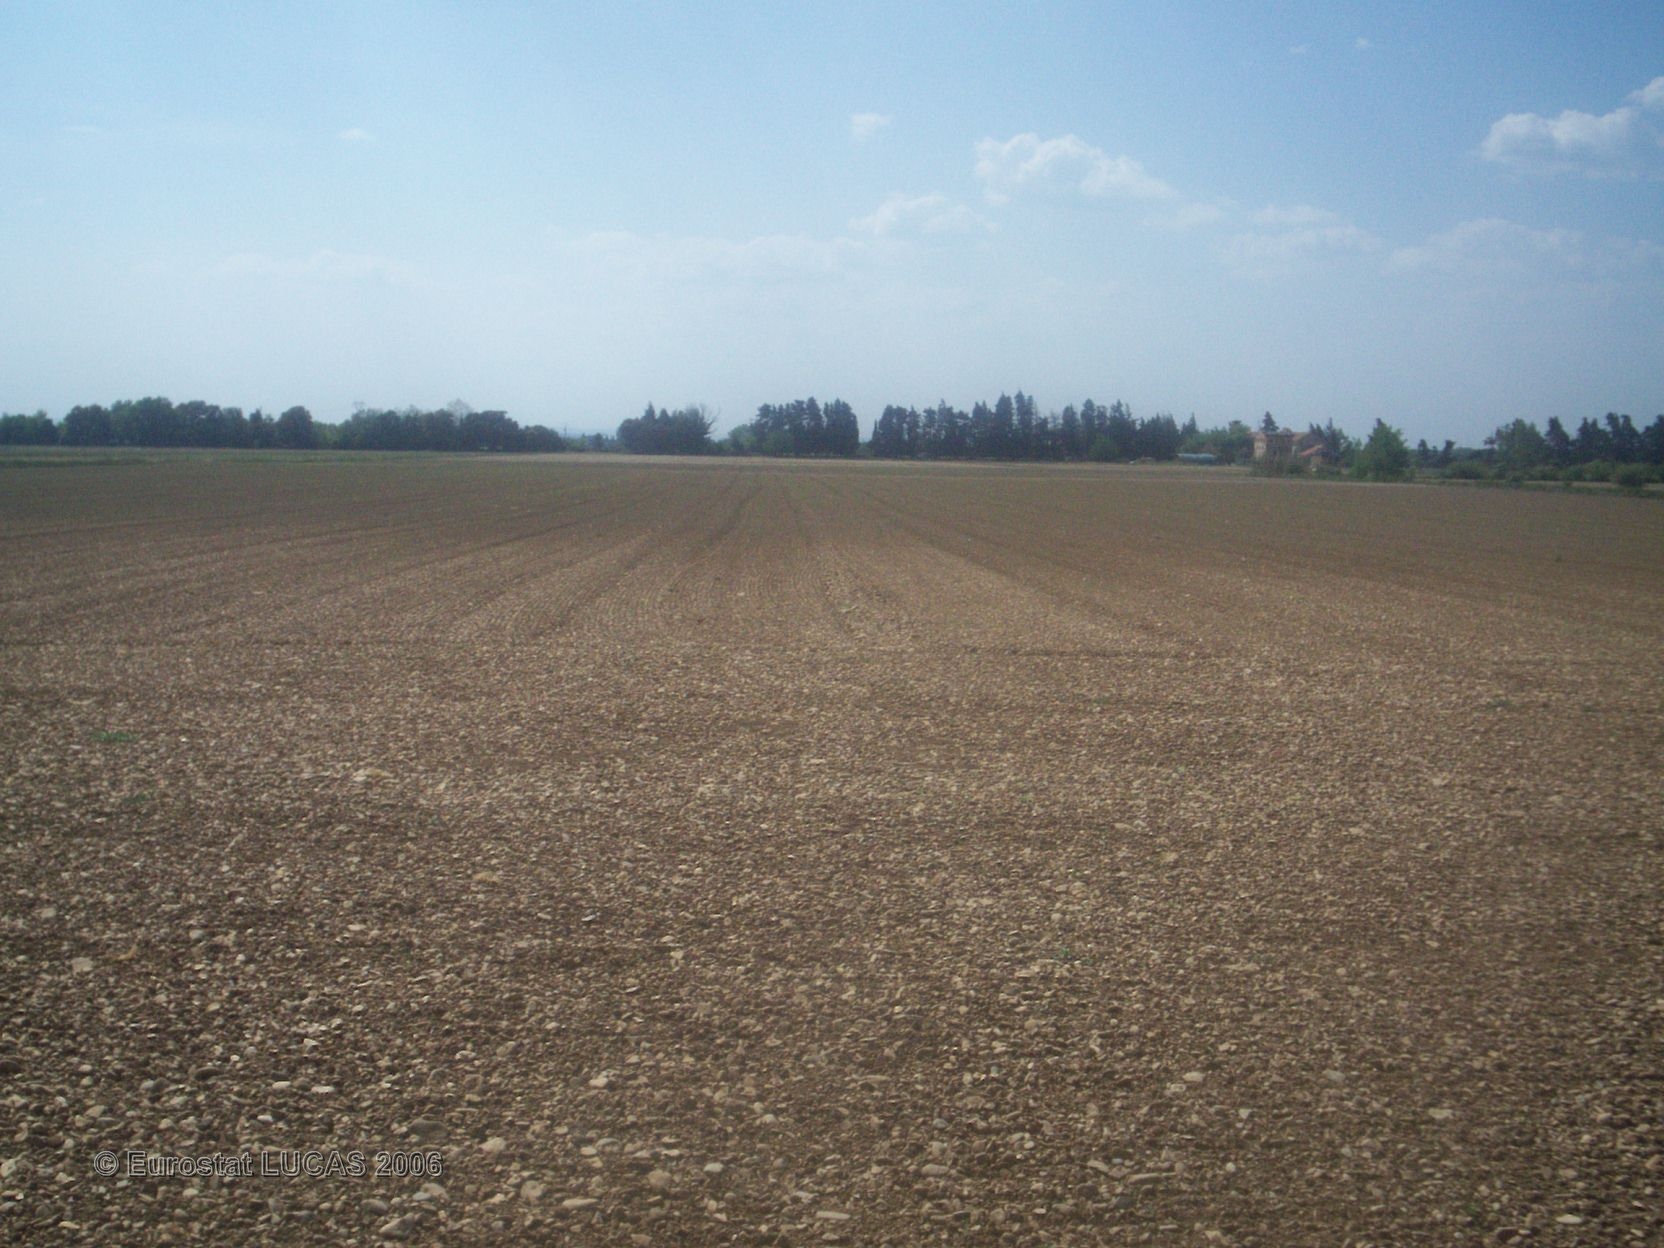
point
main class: Grassland
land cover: Grassland without tree/shrub cover
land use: Agriculture (excluding fallow land and kitchen gardens)
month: June
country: FR
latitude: 44.1371
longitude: 4.9456
